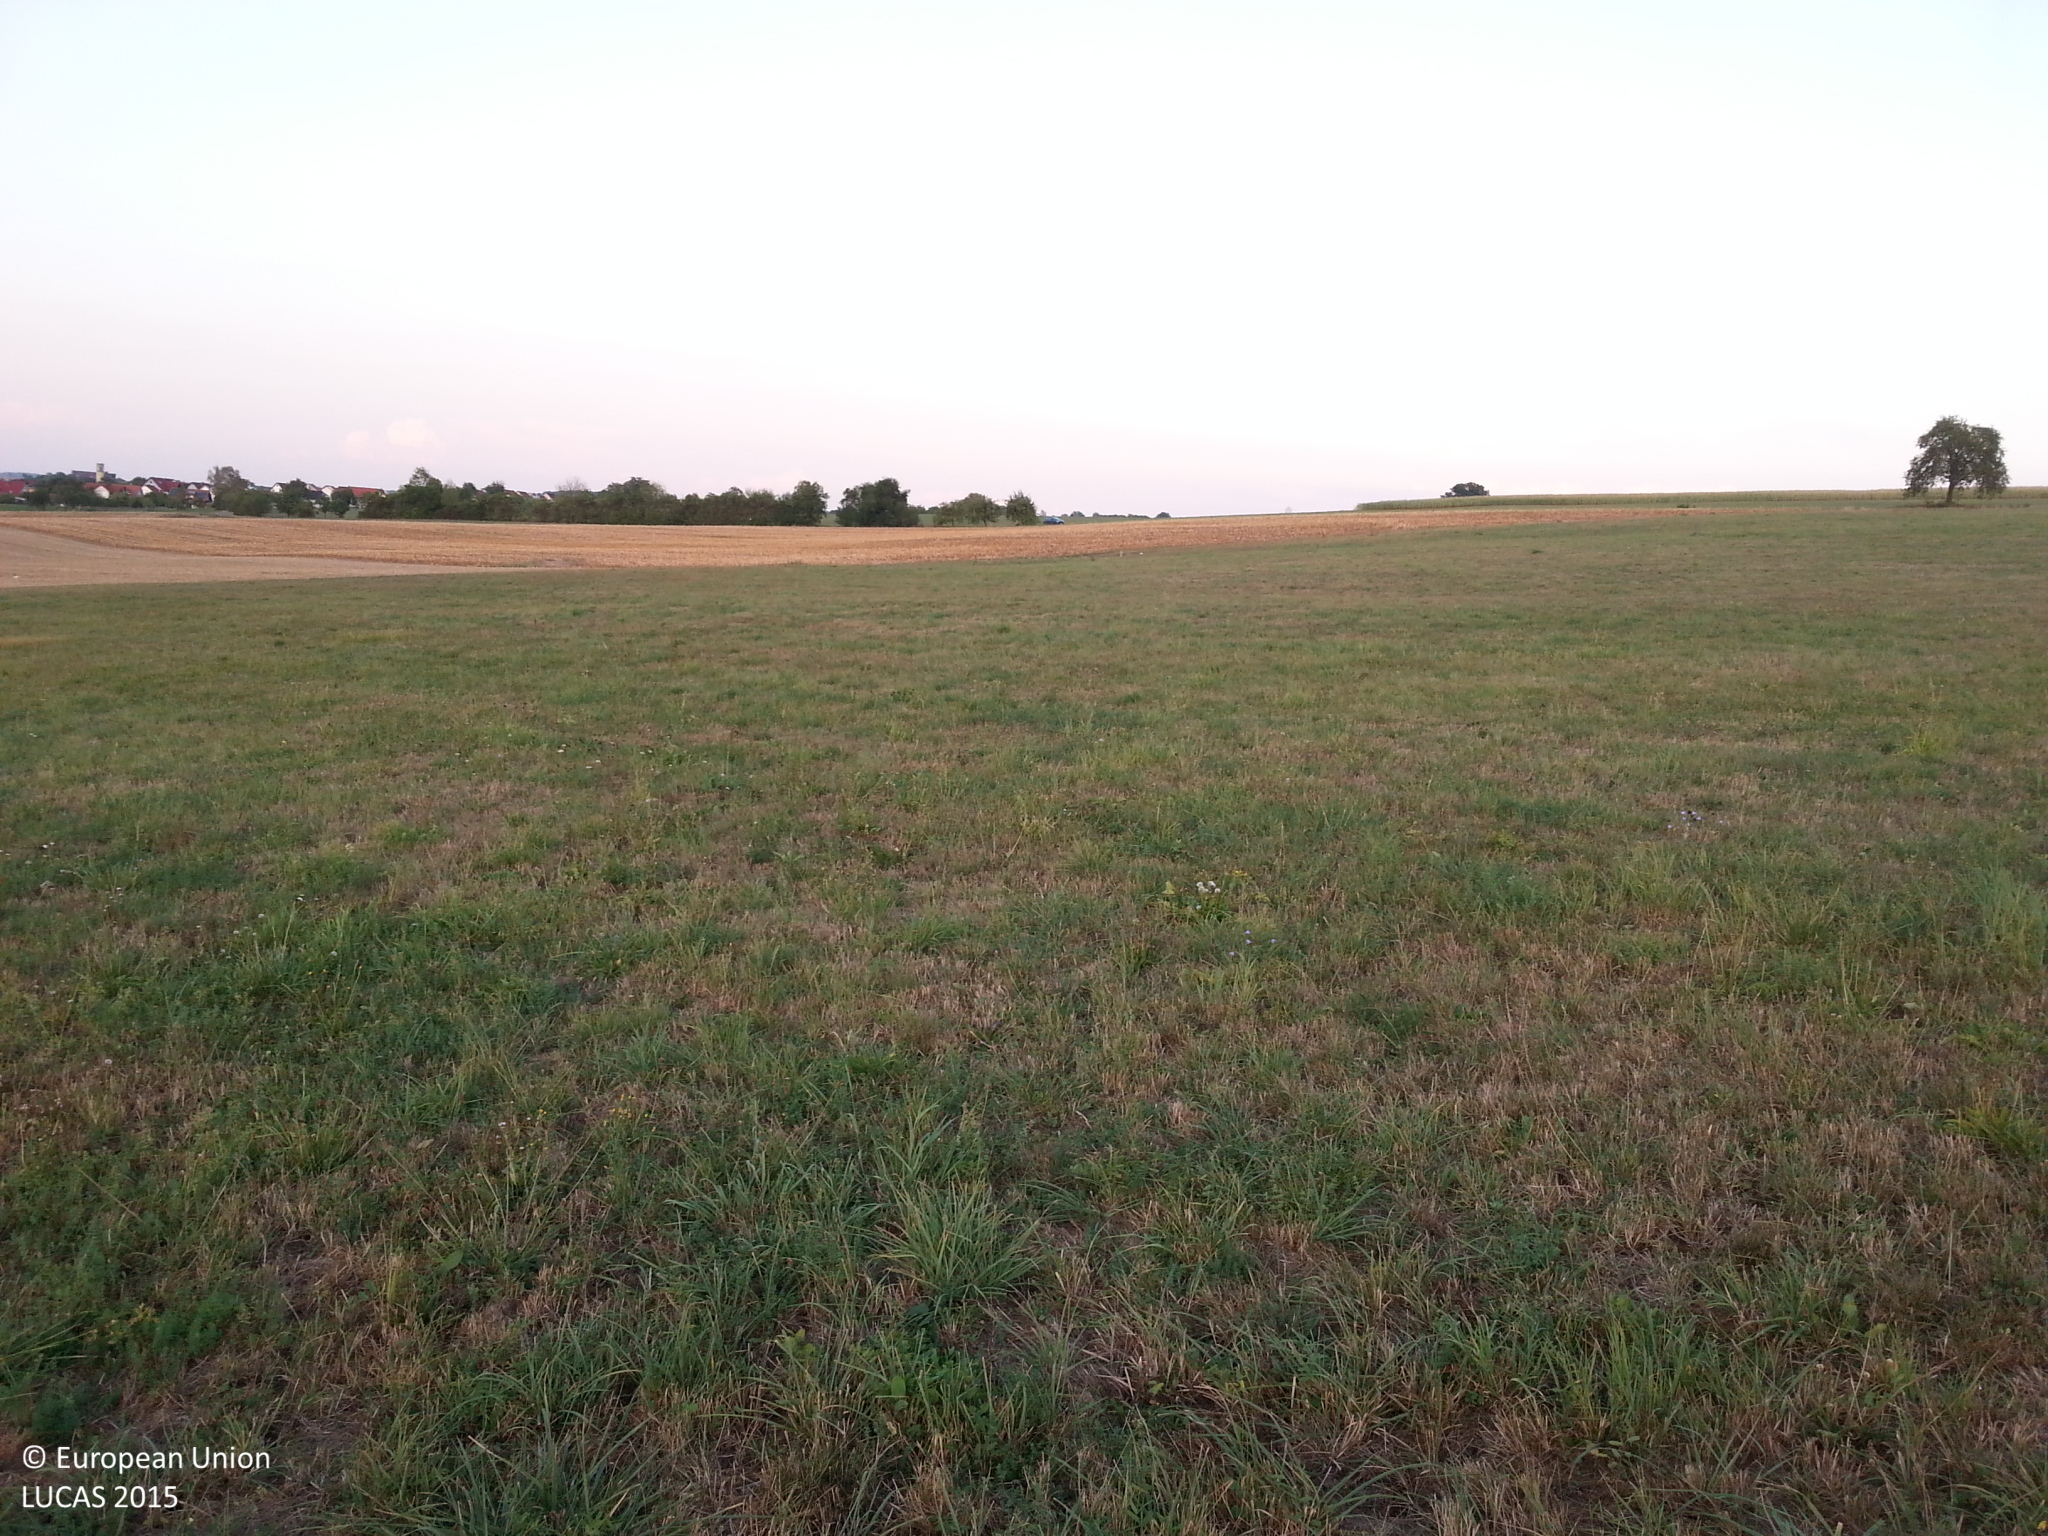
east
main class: Grassland
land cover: Grassland without tree/shrub cover
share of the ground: > 75 %
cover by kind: herbaceous plants 100 %
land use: Agriculture (excluding fallow land and kitchen gardens)
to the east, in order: Grassland without tree/shrub cover; Maize; Grass margins; Ditches and canals; Grass margins; Paved roads, cycling and walking lanes; Grass margins; Ditches and canals; Grassland without tree/shrub cover
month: August
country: DE
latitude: 49.1951
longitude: 9.9588
